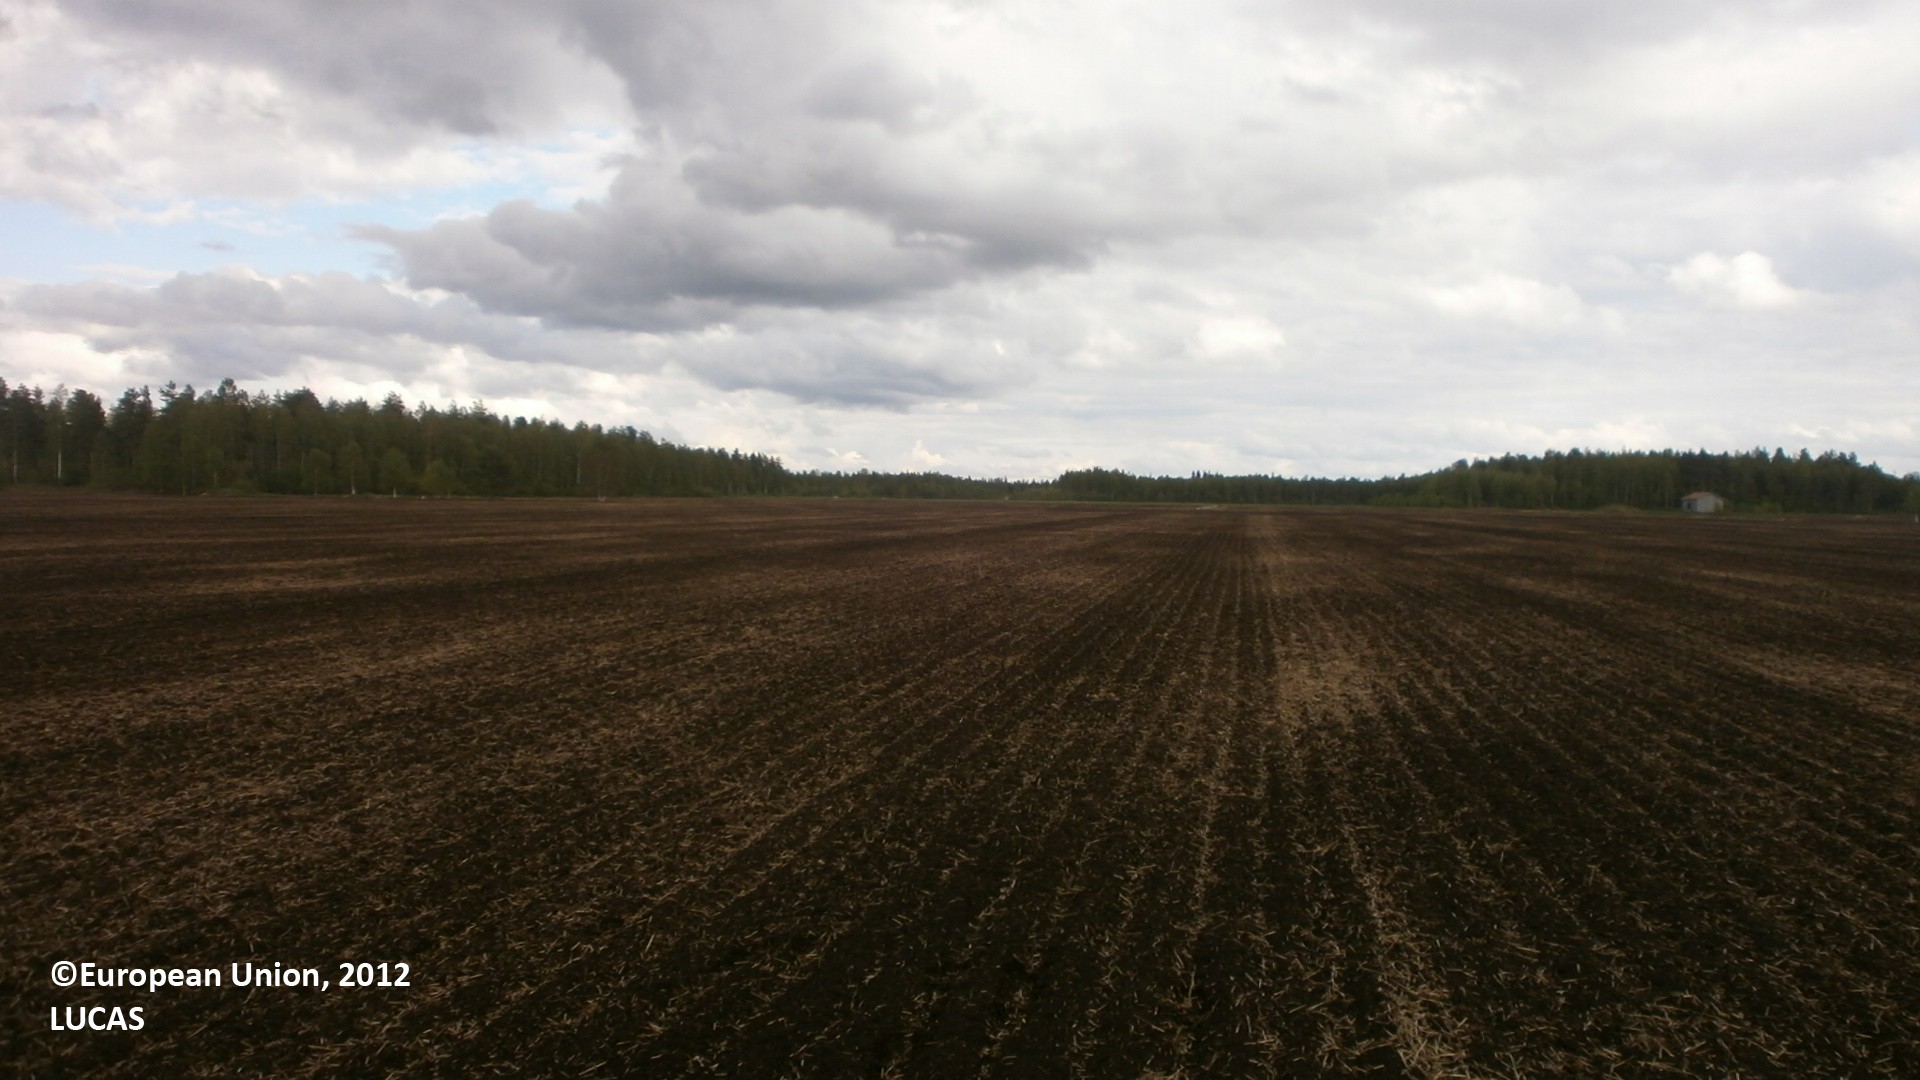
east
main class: Cropland
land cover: Barley
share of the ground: < 10 %
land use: Agriculture (excluding fallow land and kitchen gardens)
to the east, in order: Barley; Ditches and canals; Lines of trees; Grass margins; Oats
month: June
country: FI
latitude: 64.6808
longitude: 25.1481
